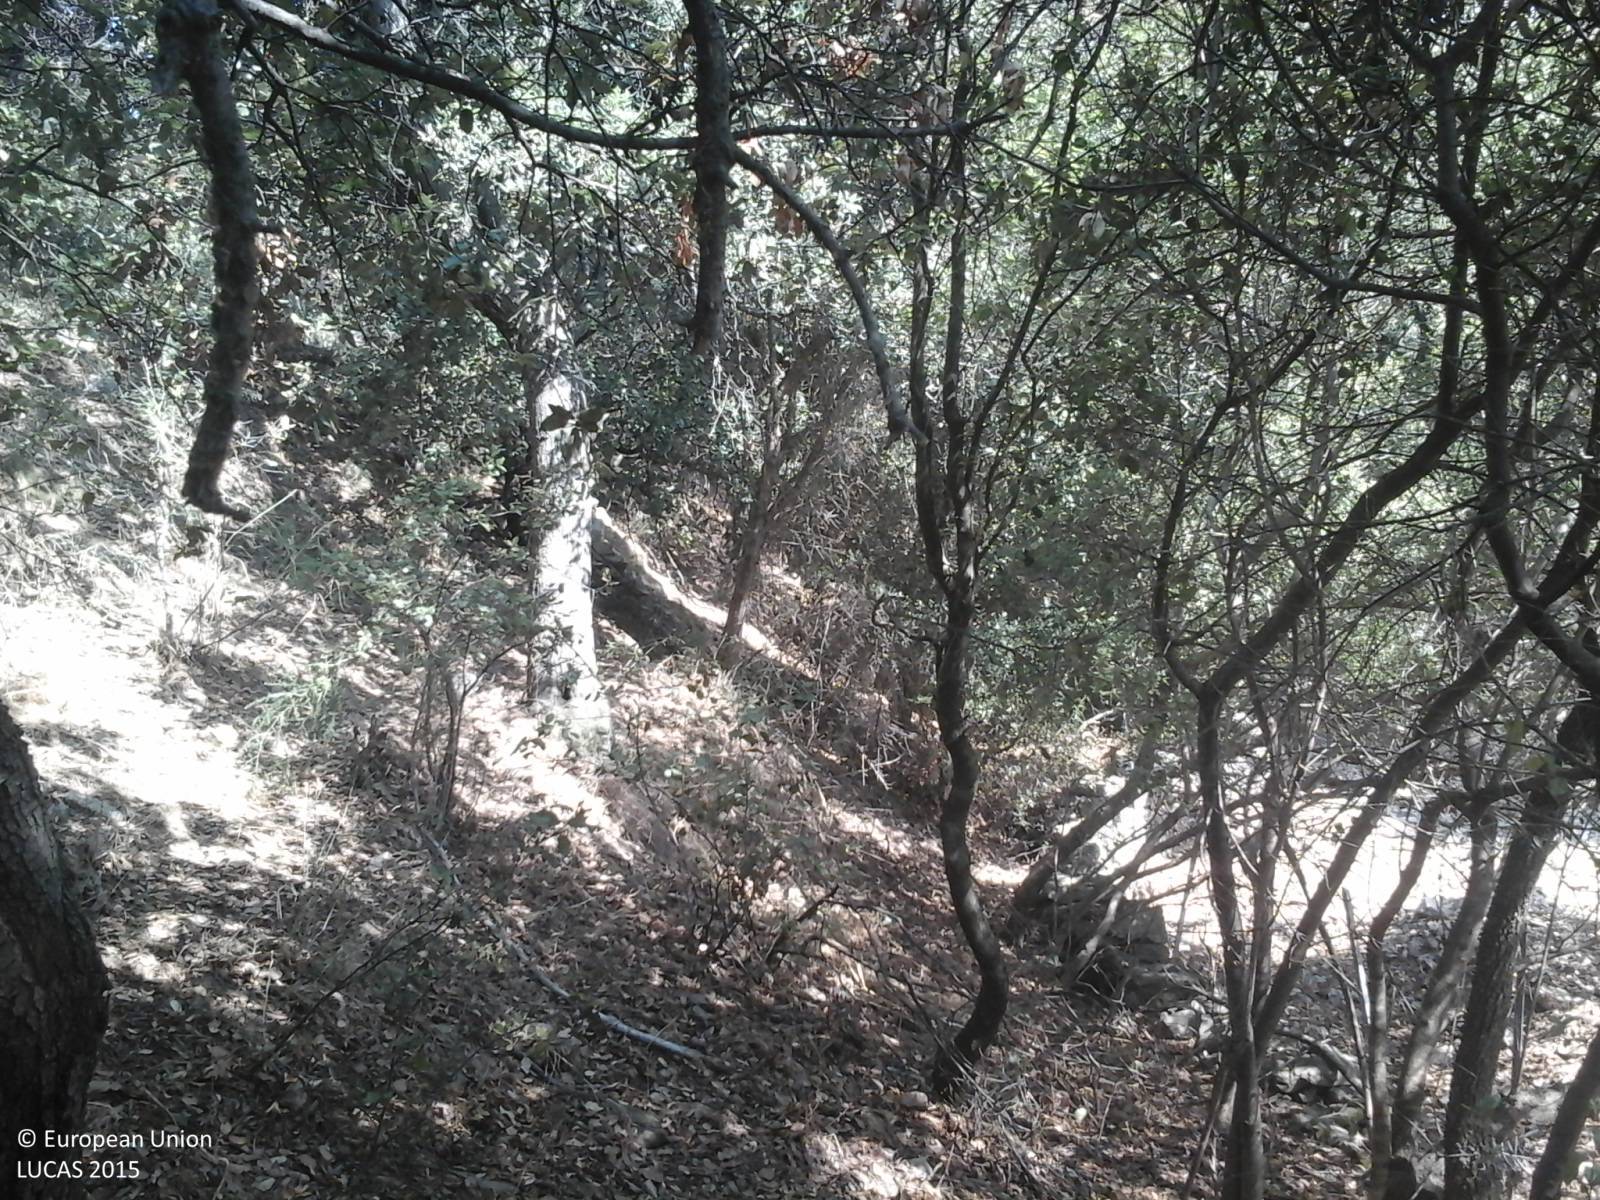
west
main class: Woodland
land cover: Broadleaved woodland
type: broadleaved evergreen forest
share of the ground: > 75 %
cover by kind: broadleaved forest trees 95 %, shrubs 5 %
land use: Forestry
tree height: > 5 m
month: July
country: IT
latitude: 40.7729
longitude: 9.5166
